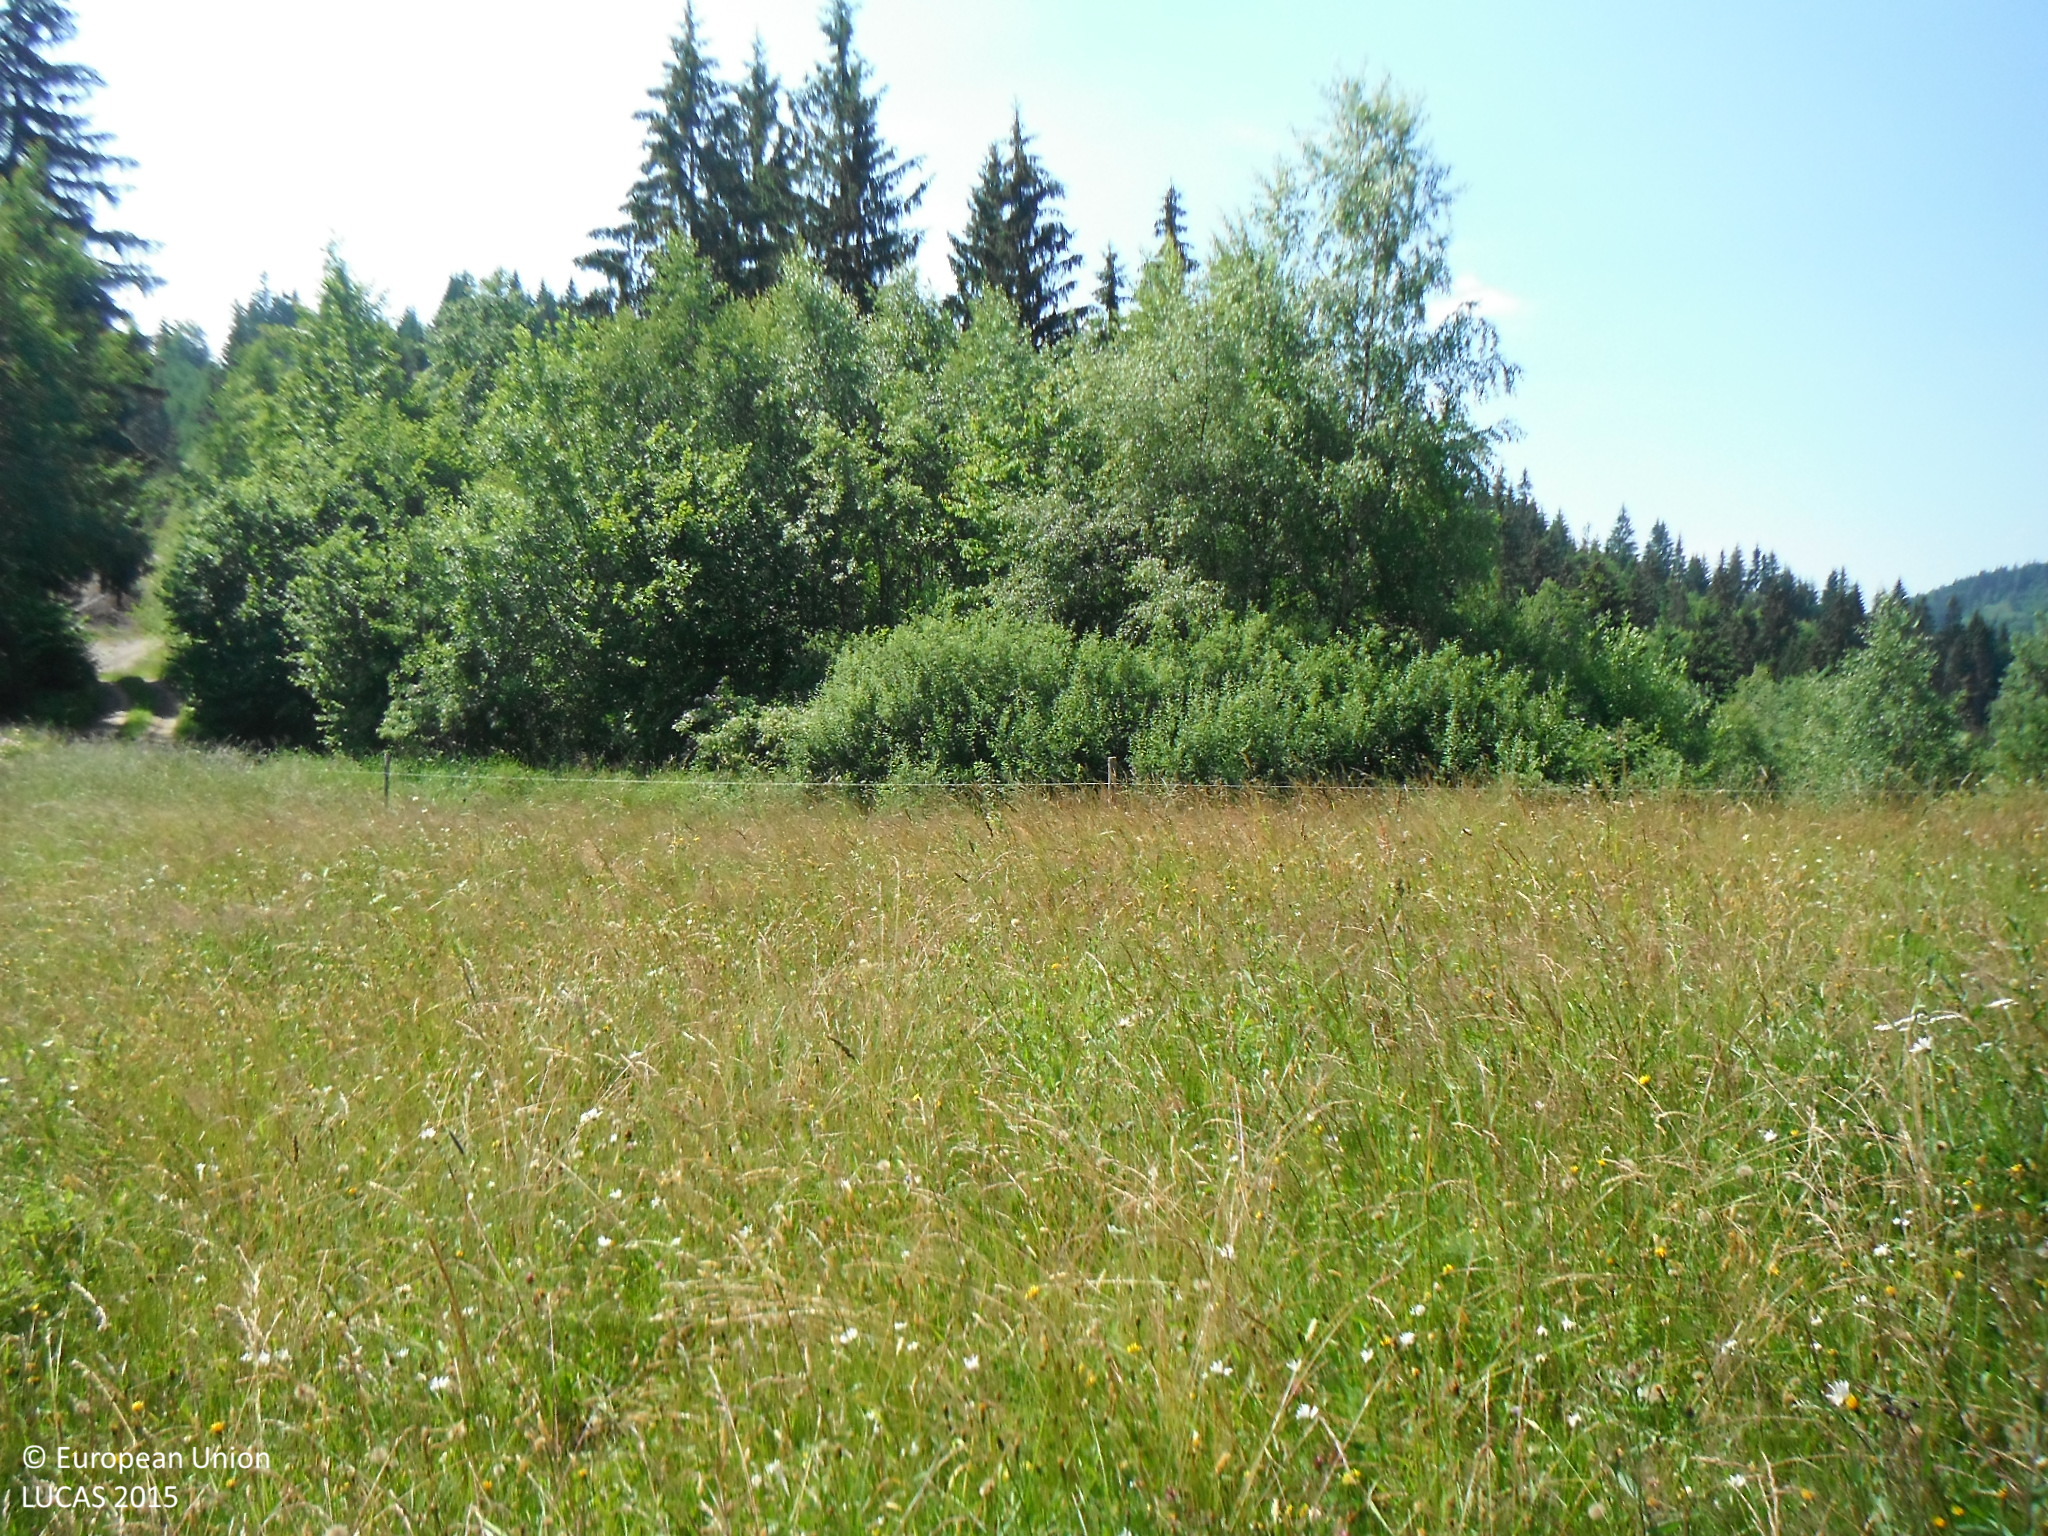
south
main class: Grassland
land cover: Grassland without tree/shrub cover
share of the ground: > 75 %
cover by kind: herbaceous plants 95 %, shrubs 5 %
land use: Agriculture (excluding fallow land and kitchen gardens)
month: July
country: SK
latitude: 49.3412
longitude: 18.5103
